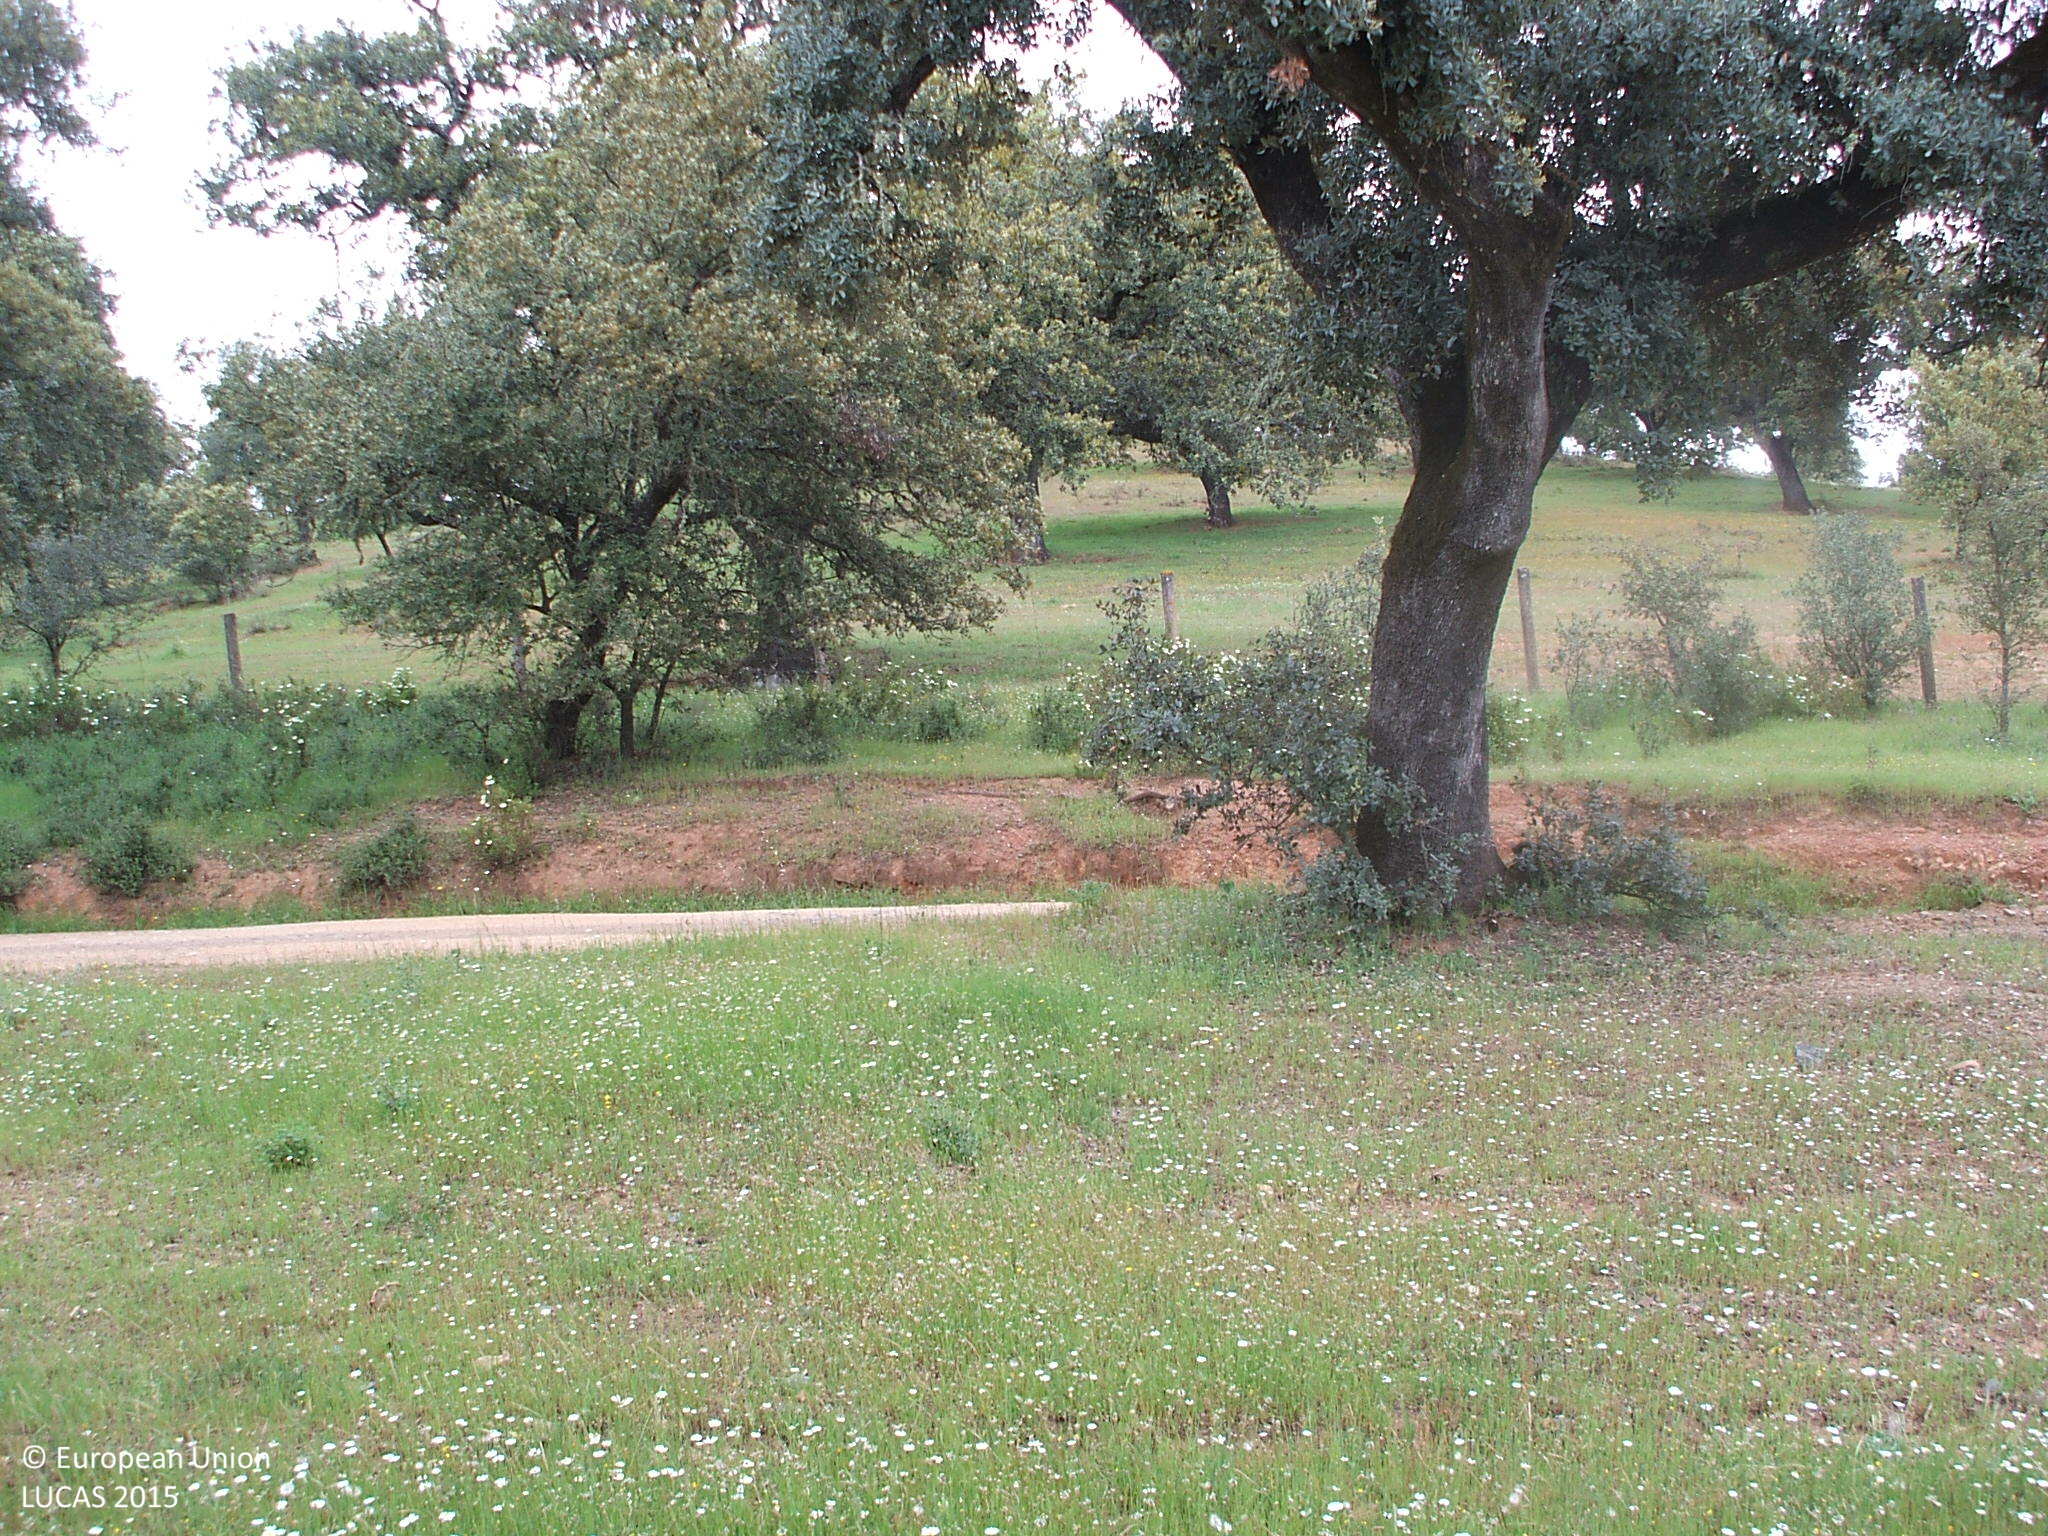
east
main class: Woodland
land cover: Broadleaved woodland
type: broadleaved evergreen forest
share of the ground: 25 - 50 %
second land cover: Grassland without tree/shrub cover
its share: > 75 %
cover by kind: herbaceous plants 60 %, broadleaved forest trees 40 %
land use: Forestry
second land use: Agriculture (excluding fallow land and kitchen gardens)
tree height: > 5 m
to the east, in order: Broadleaved woodland; Grassland without tree/shrub cover; Rivers and streams; Broadleaved woodland; Rivers and streams; Broadleaved woodland
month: April
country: ES
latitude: 38.0630
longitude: -5.6568
